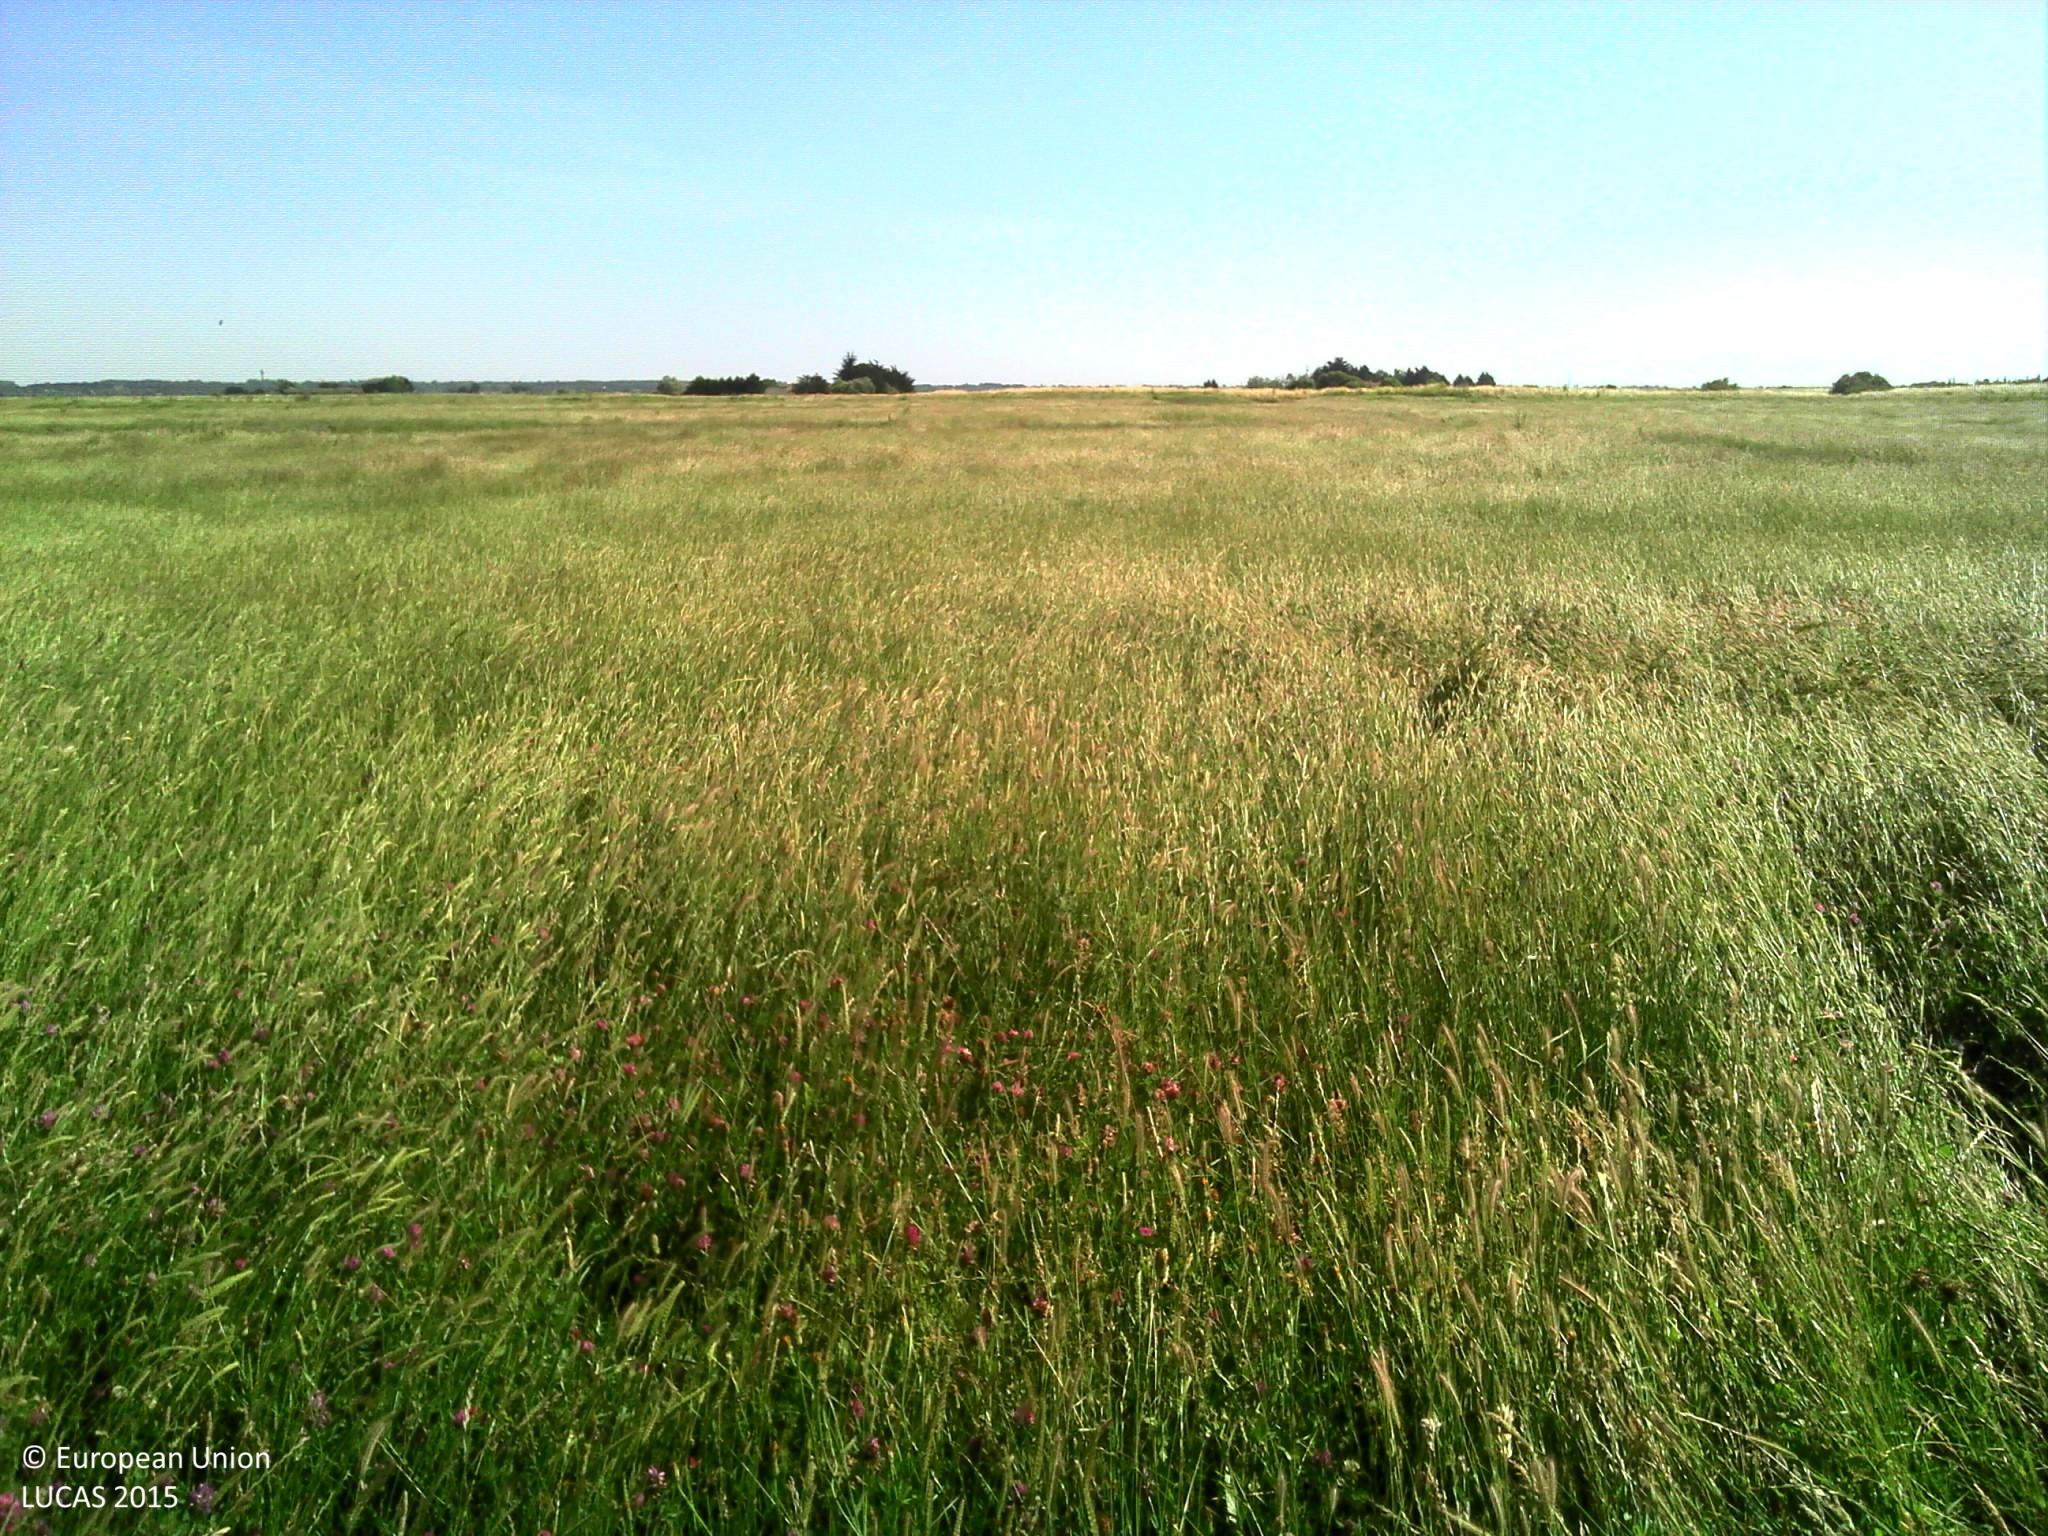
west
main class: Grassland
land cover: Grassland without tree/shrub cover
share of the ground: > 75 %
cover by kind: herbaceous plants 100 %
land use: Agriculture (excluding fallow land and kitchen gardens)
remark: Temporary flooded
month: June
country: FR
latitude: 46.9657
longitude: -1.9935
